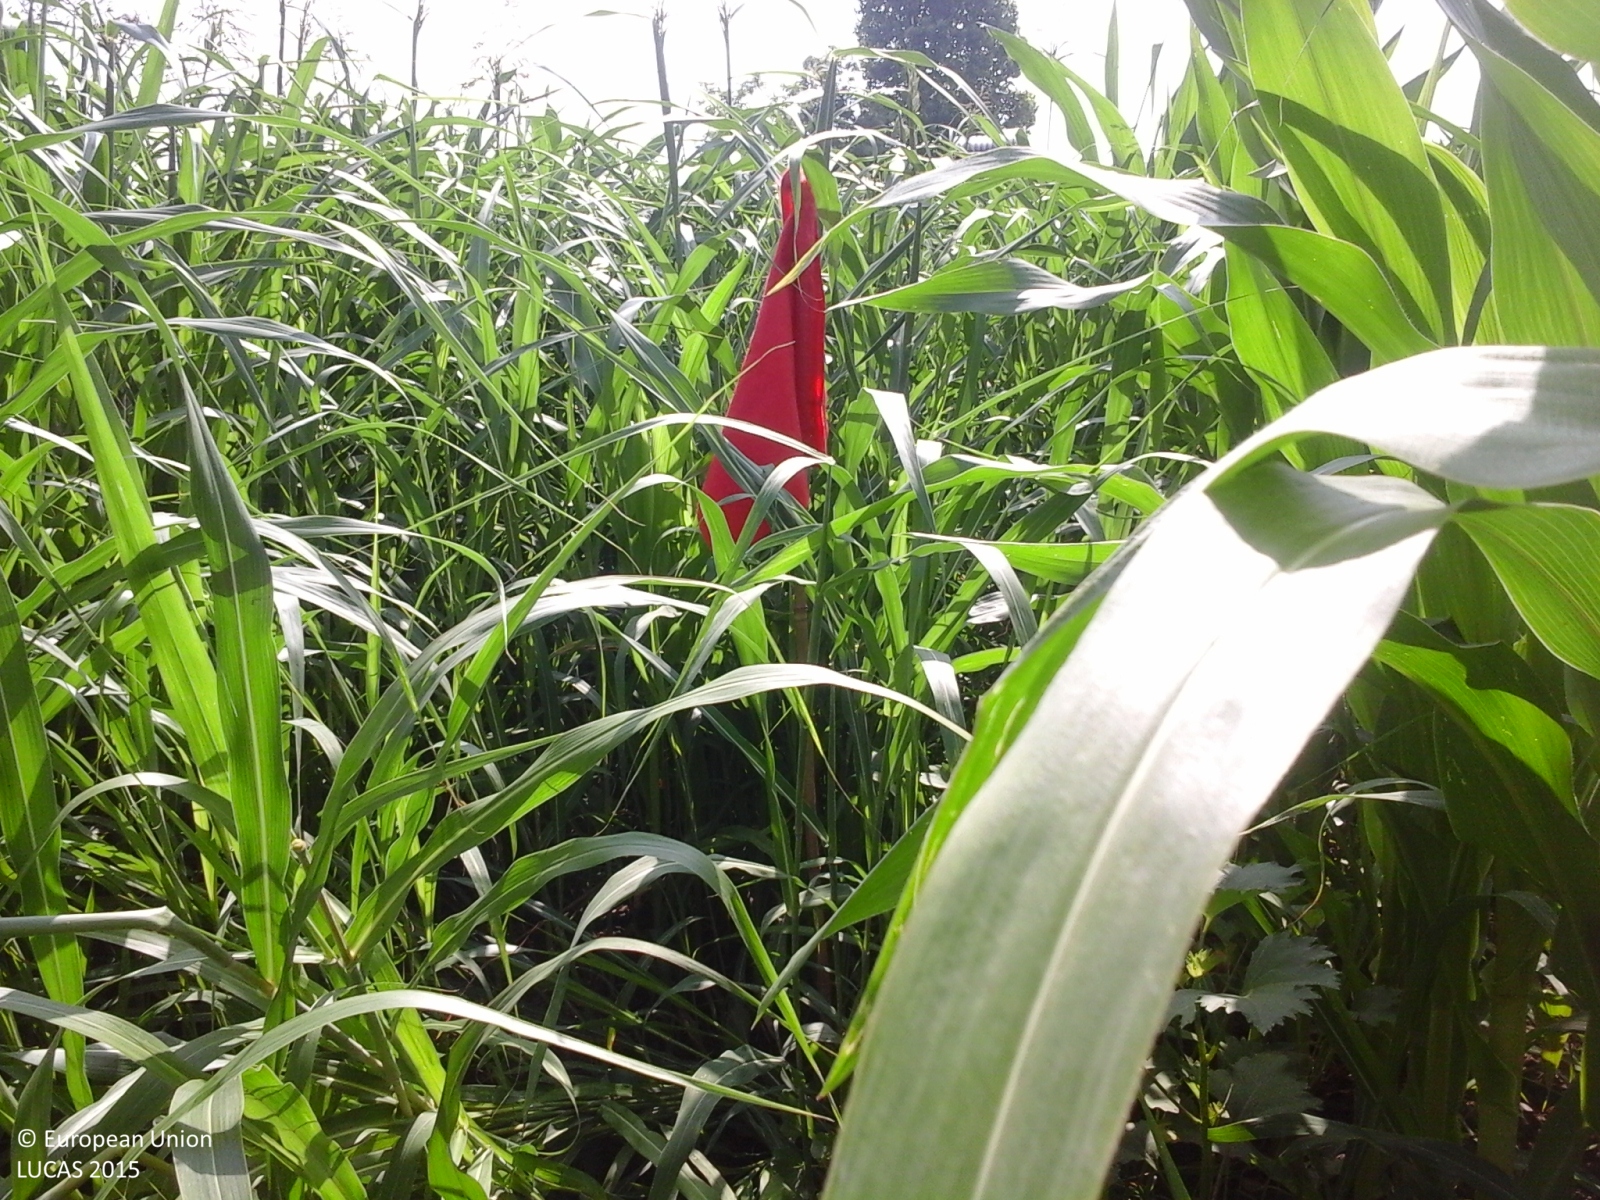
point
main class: Cropland
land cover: Maize
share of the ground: > 75 %
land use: Agriculture (excluding fallow land and kitchen gardens)
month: June
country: IT
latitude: 45.2102
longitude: 11.1057
